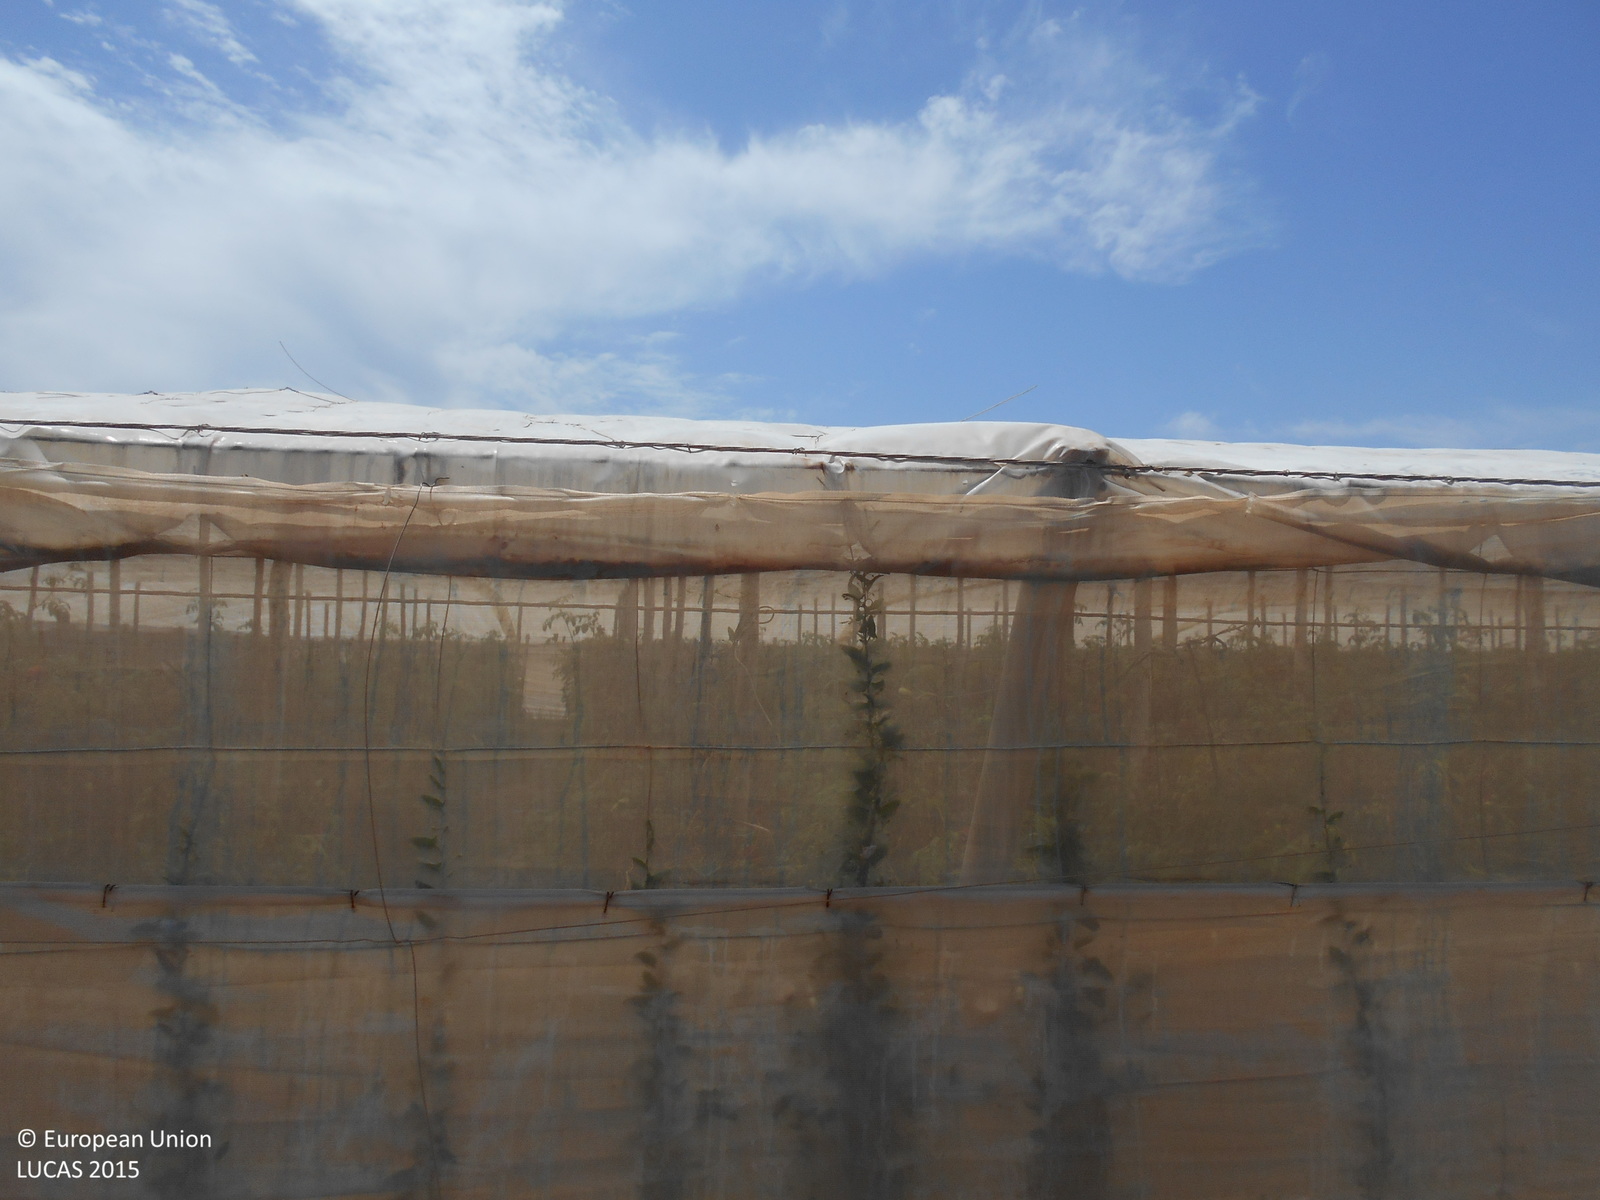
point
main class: Artificial land
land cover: Greenhouses
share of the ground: > 75 %
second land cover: Tomatoes
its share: 25 - 50 %
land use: Agriculture (excluding fallow land and kitchen gardens)
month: May
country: ES
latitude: 36.7911
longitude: -2.2216
